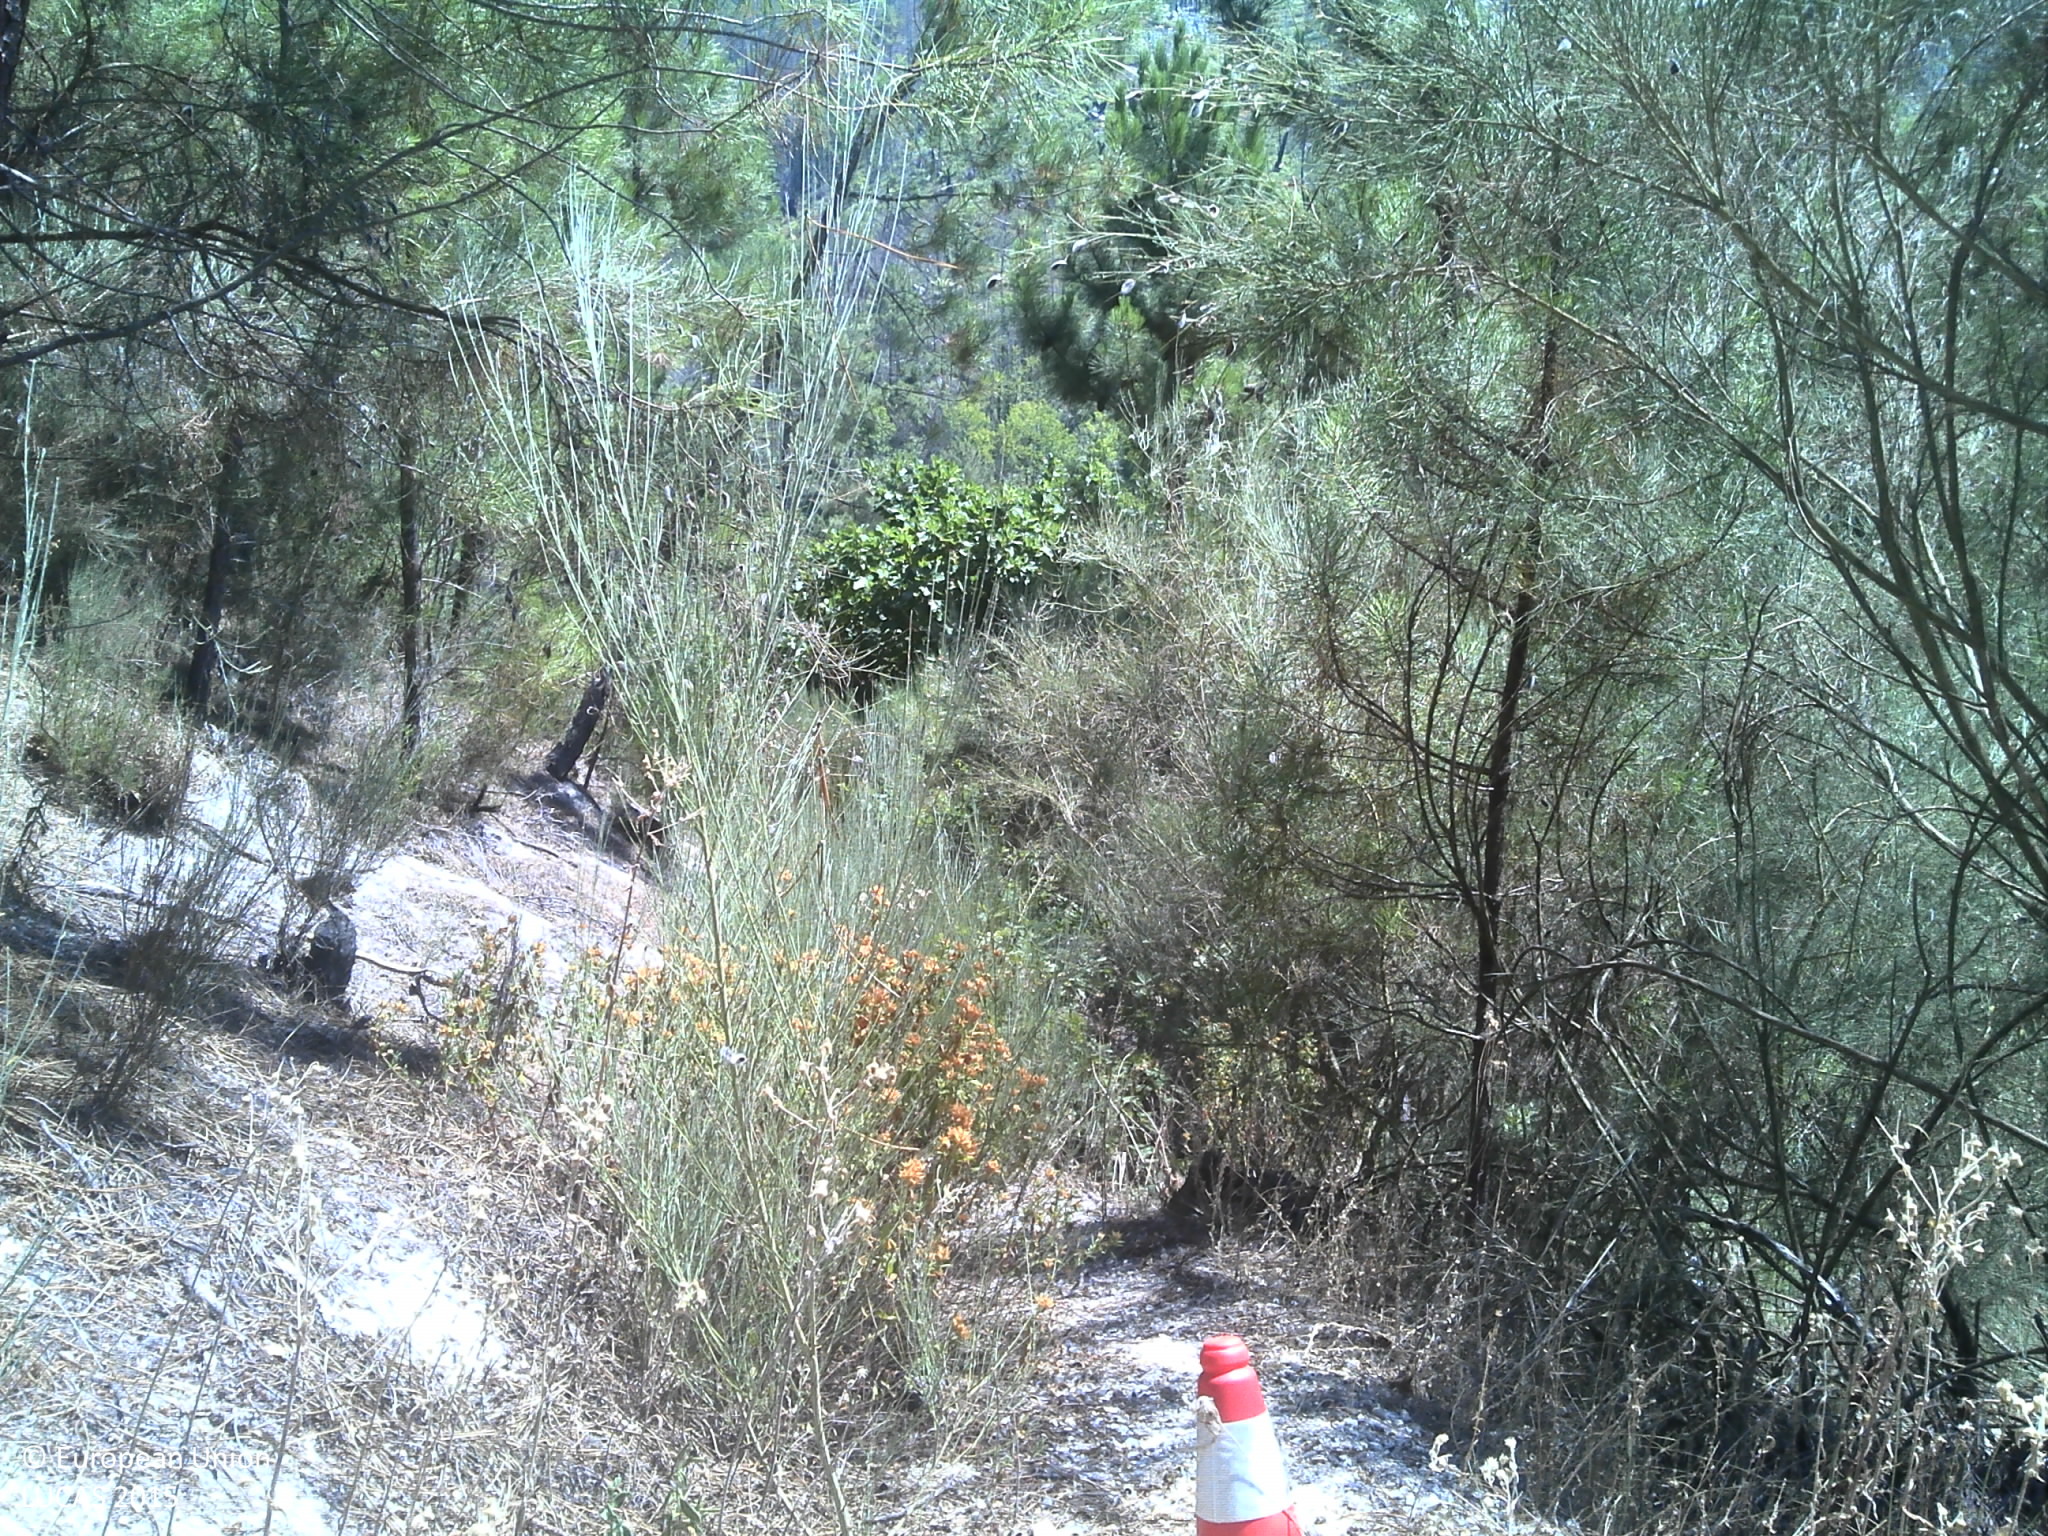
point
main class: Shrubland
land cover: Shrubland with sparse tree cover
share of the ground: 50 - 75 %
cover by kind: shrubs 75 %, unconsolidated bare surface 20 %, coniferous forest trees 5 %
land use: Abandoned areas
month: July
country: PT
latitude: 40.3751
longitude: -7.7226
